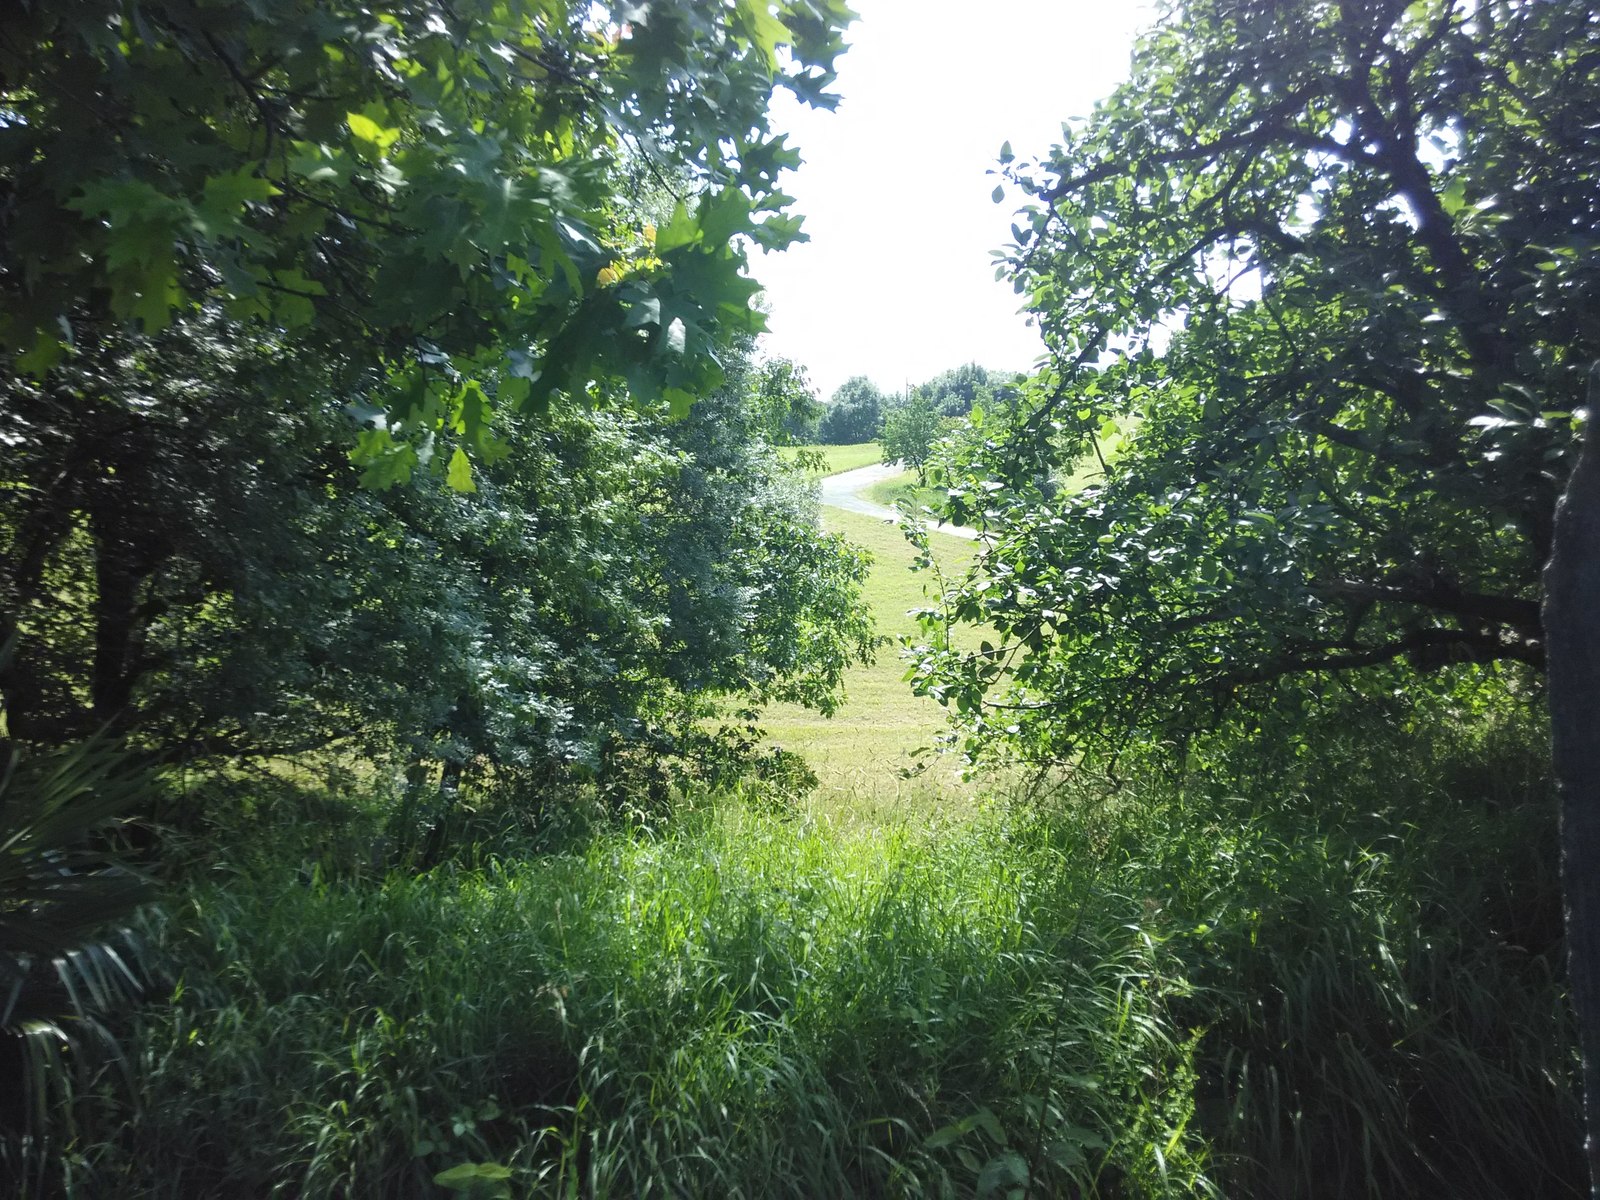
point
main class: Woodland
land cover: Broadleaved woodland
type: acidophilous oak and oak-birch forest
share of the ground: > 75 %
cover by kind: broadleaved forest trees 95 %, herbaceous plants 5 %
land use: Forestry
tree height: > 5 m
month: June
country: ES
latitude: 43.3204
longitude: -1.8713
